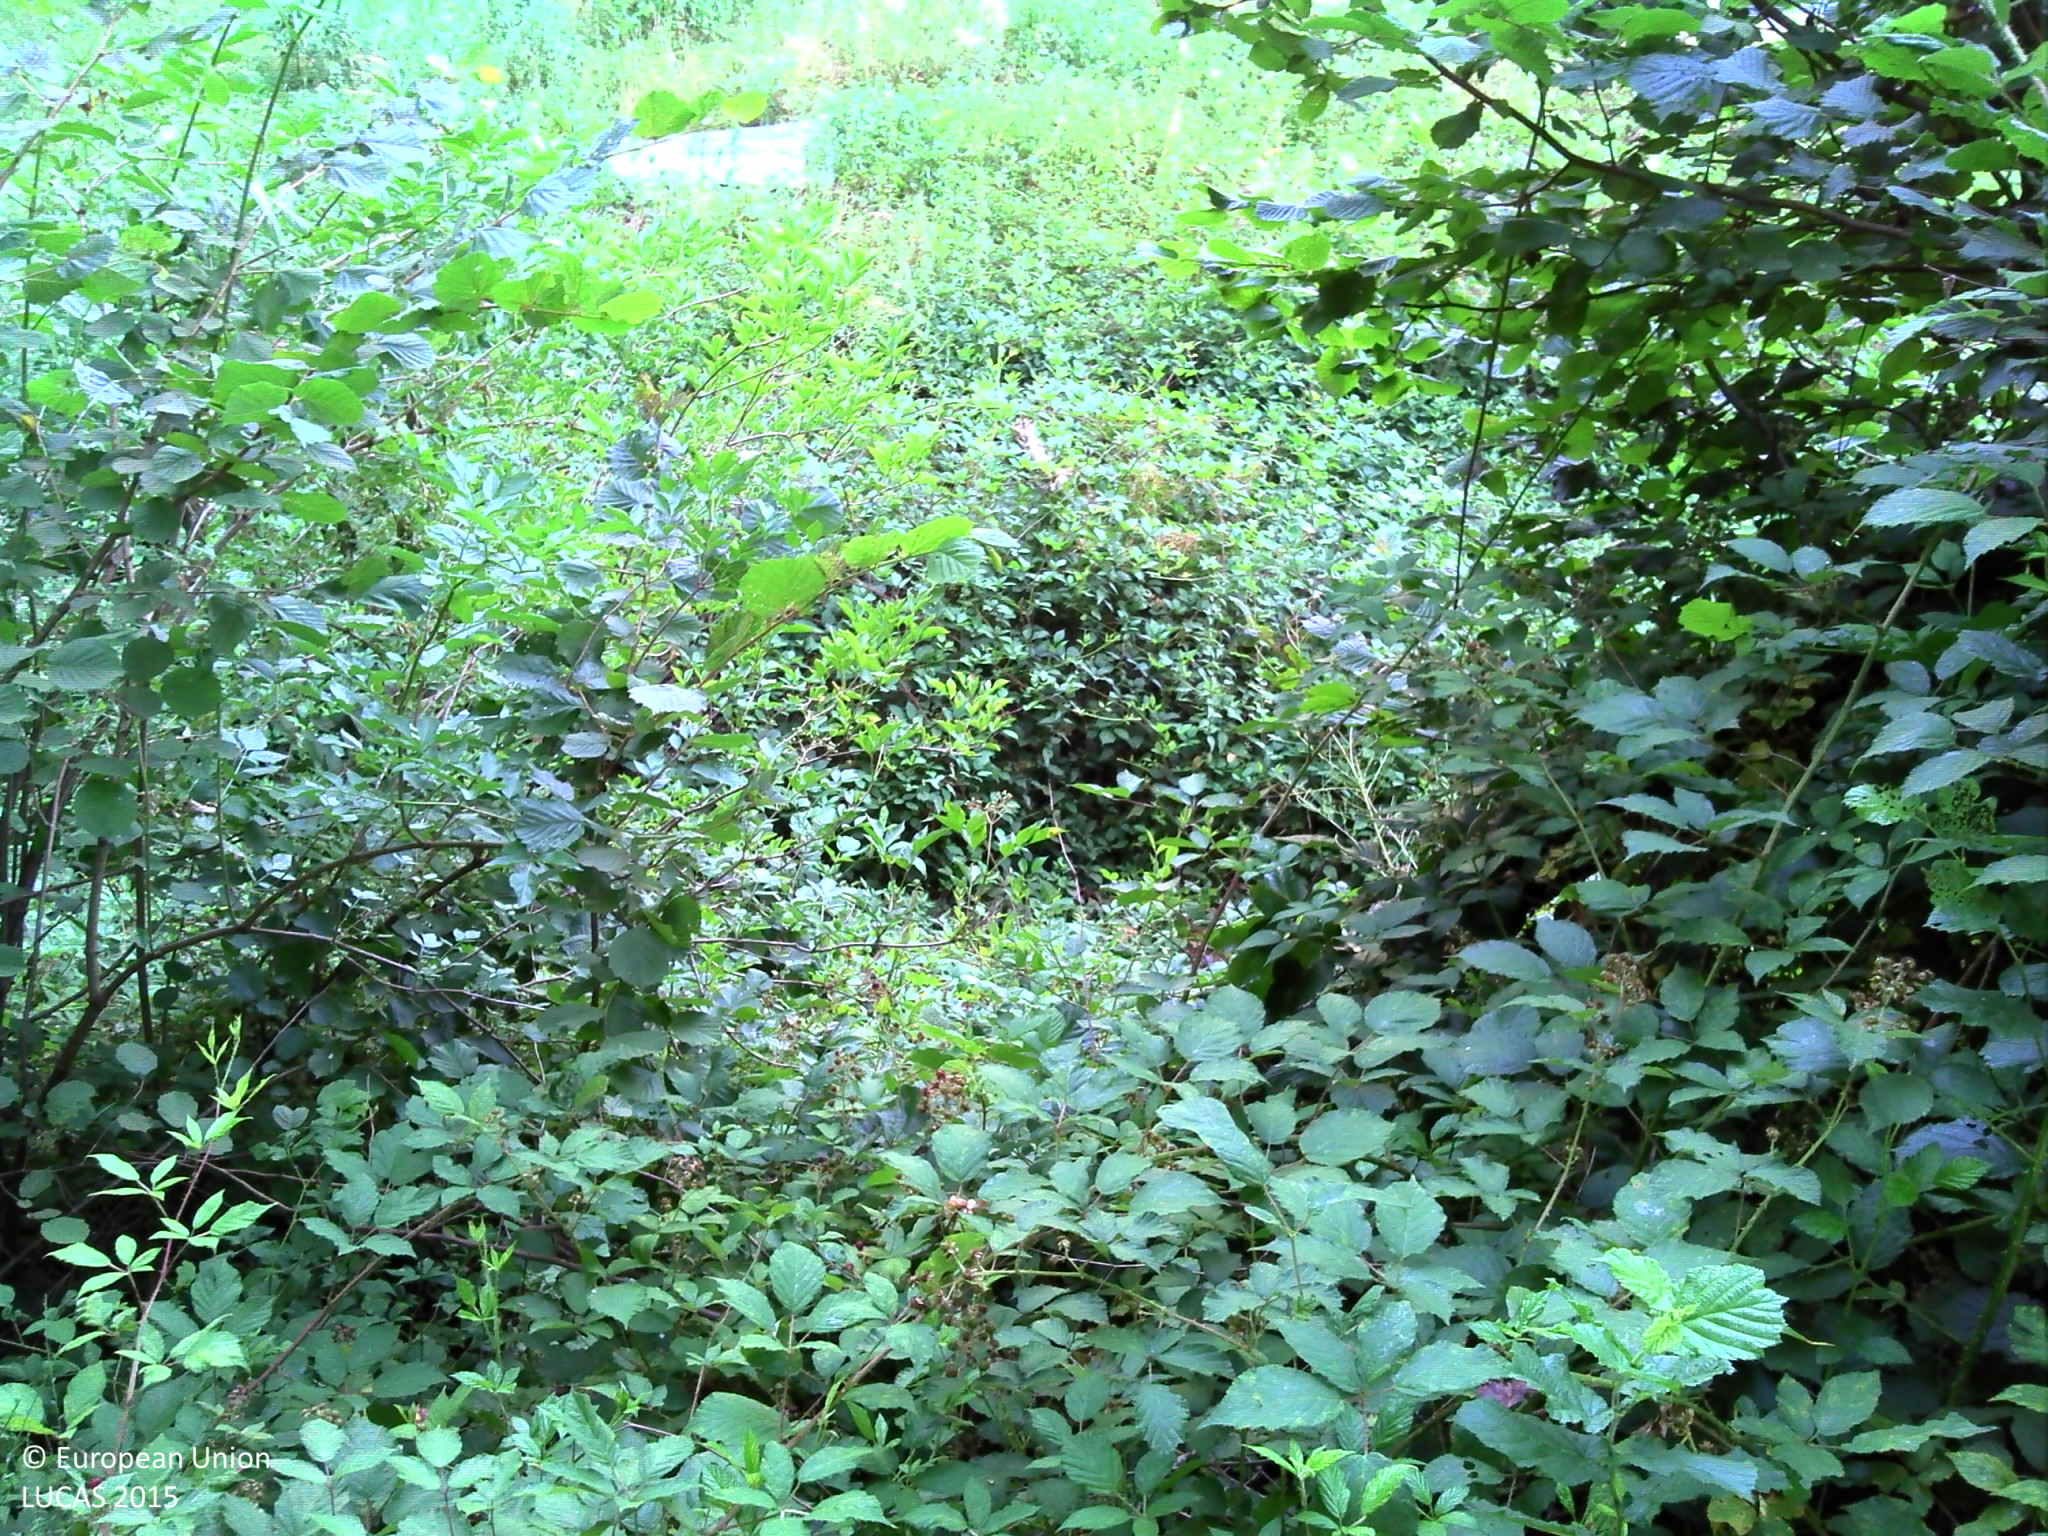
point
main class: Woodland
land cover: Broadleaved woodland
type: acidophilous oak and oak-birch forest
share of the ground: > 75 %
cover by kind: broadleaved forest trees 75 %, shrubs 20 %, herbaceous plants 5 %
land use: Forestry
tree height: > 5 m
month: July
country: FR
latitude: 44.4940
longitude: 2.9994
